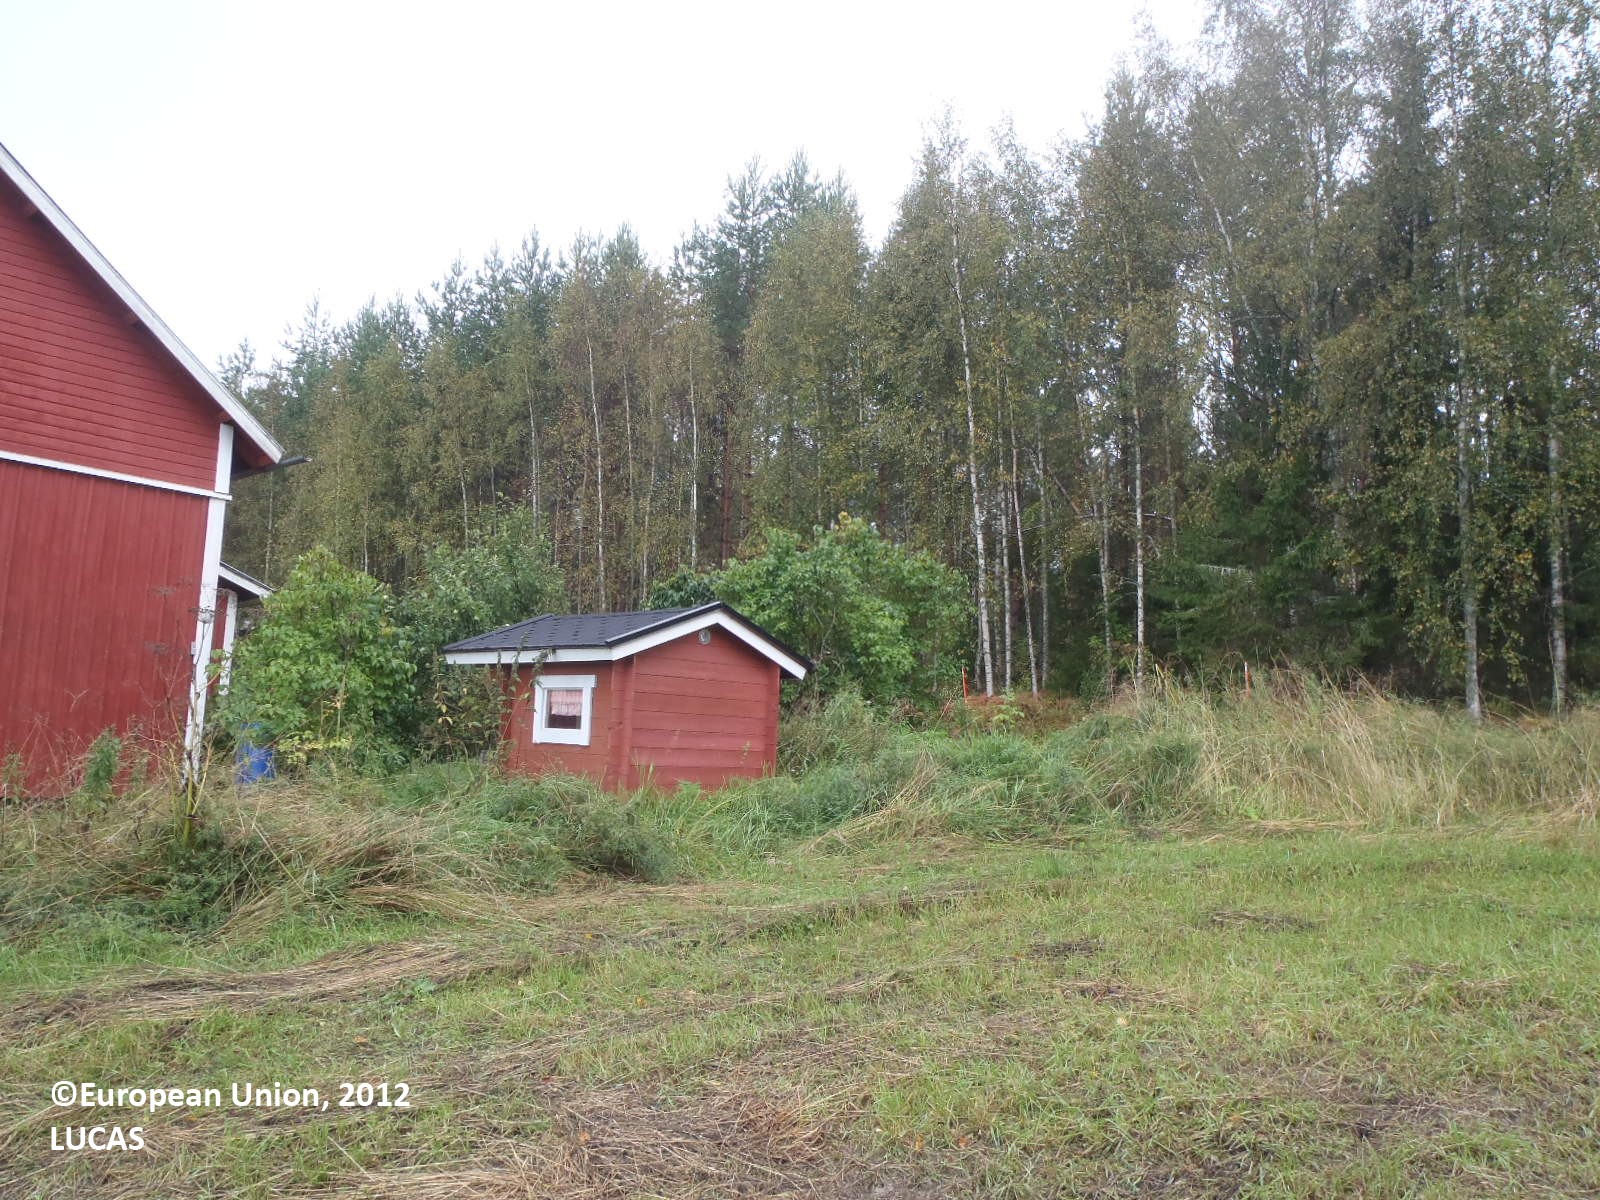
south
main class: Cropland
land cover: Temporary grasslands
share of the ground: > 75 %
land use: Agriculture (excluding fallow land and kitchen gardens)
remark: Harvested field
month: September
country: FI
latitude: 61.5567
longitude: 22.7330
